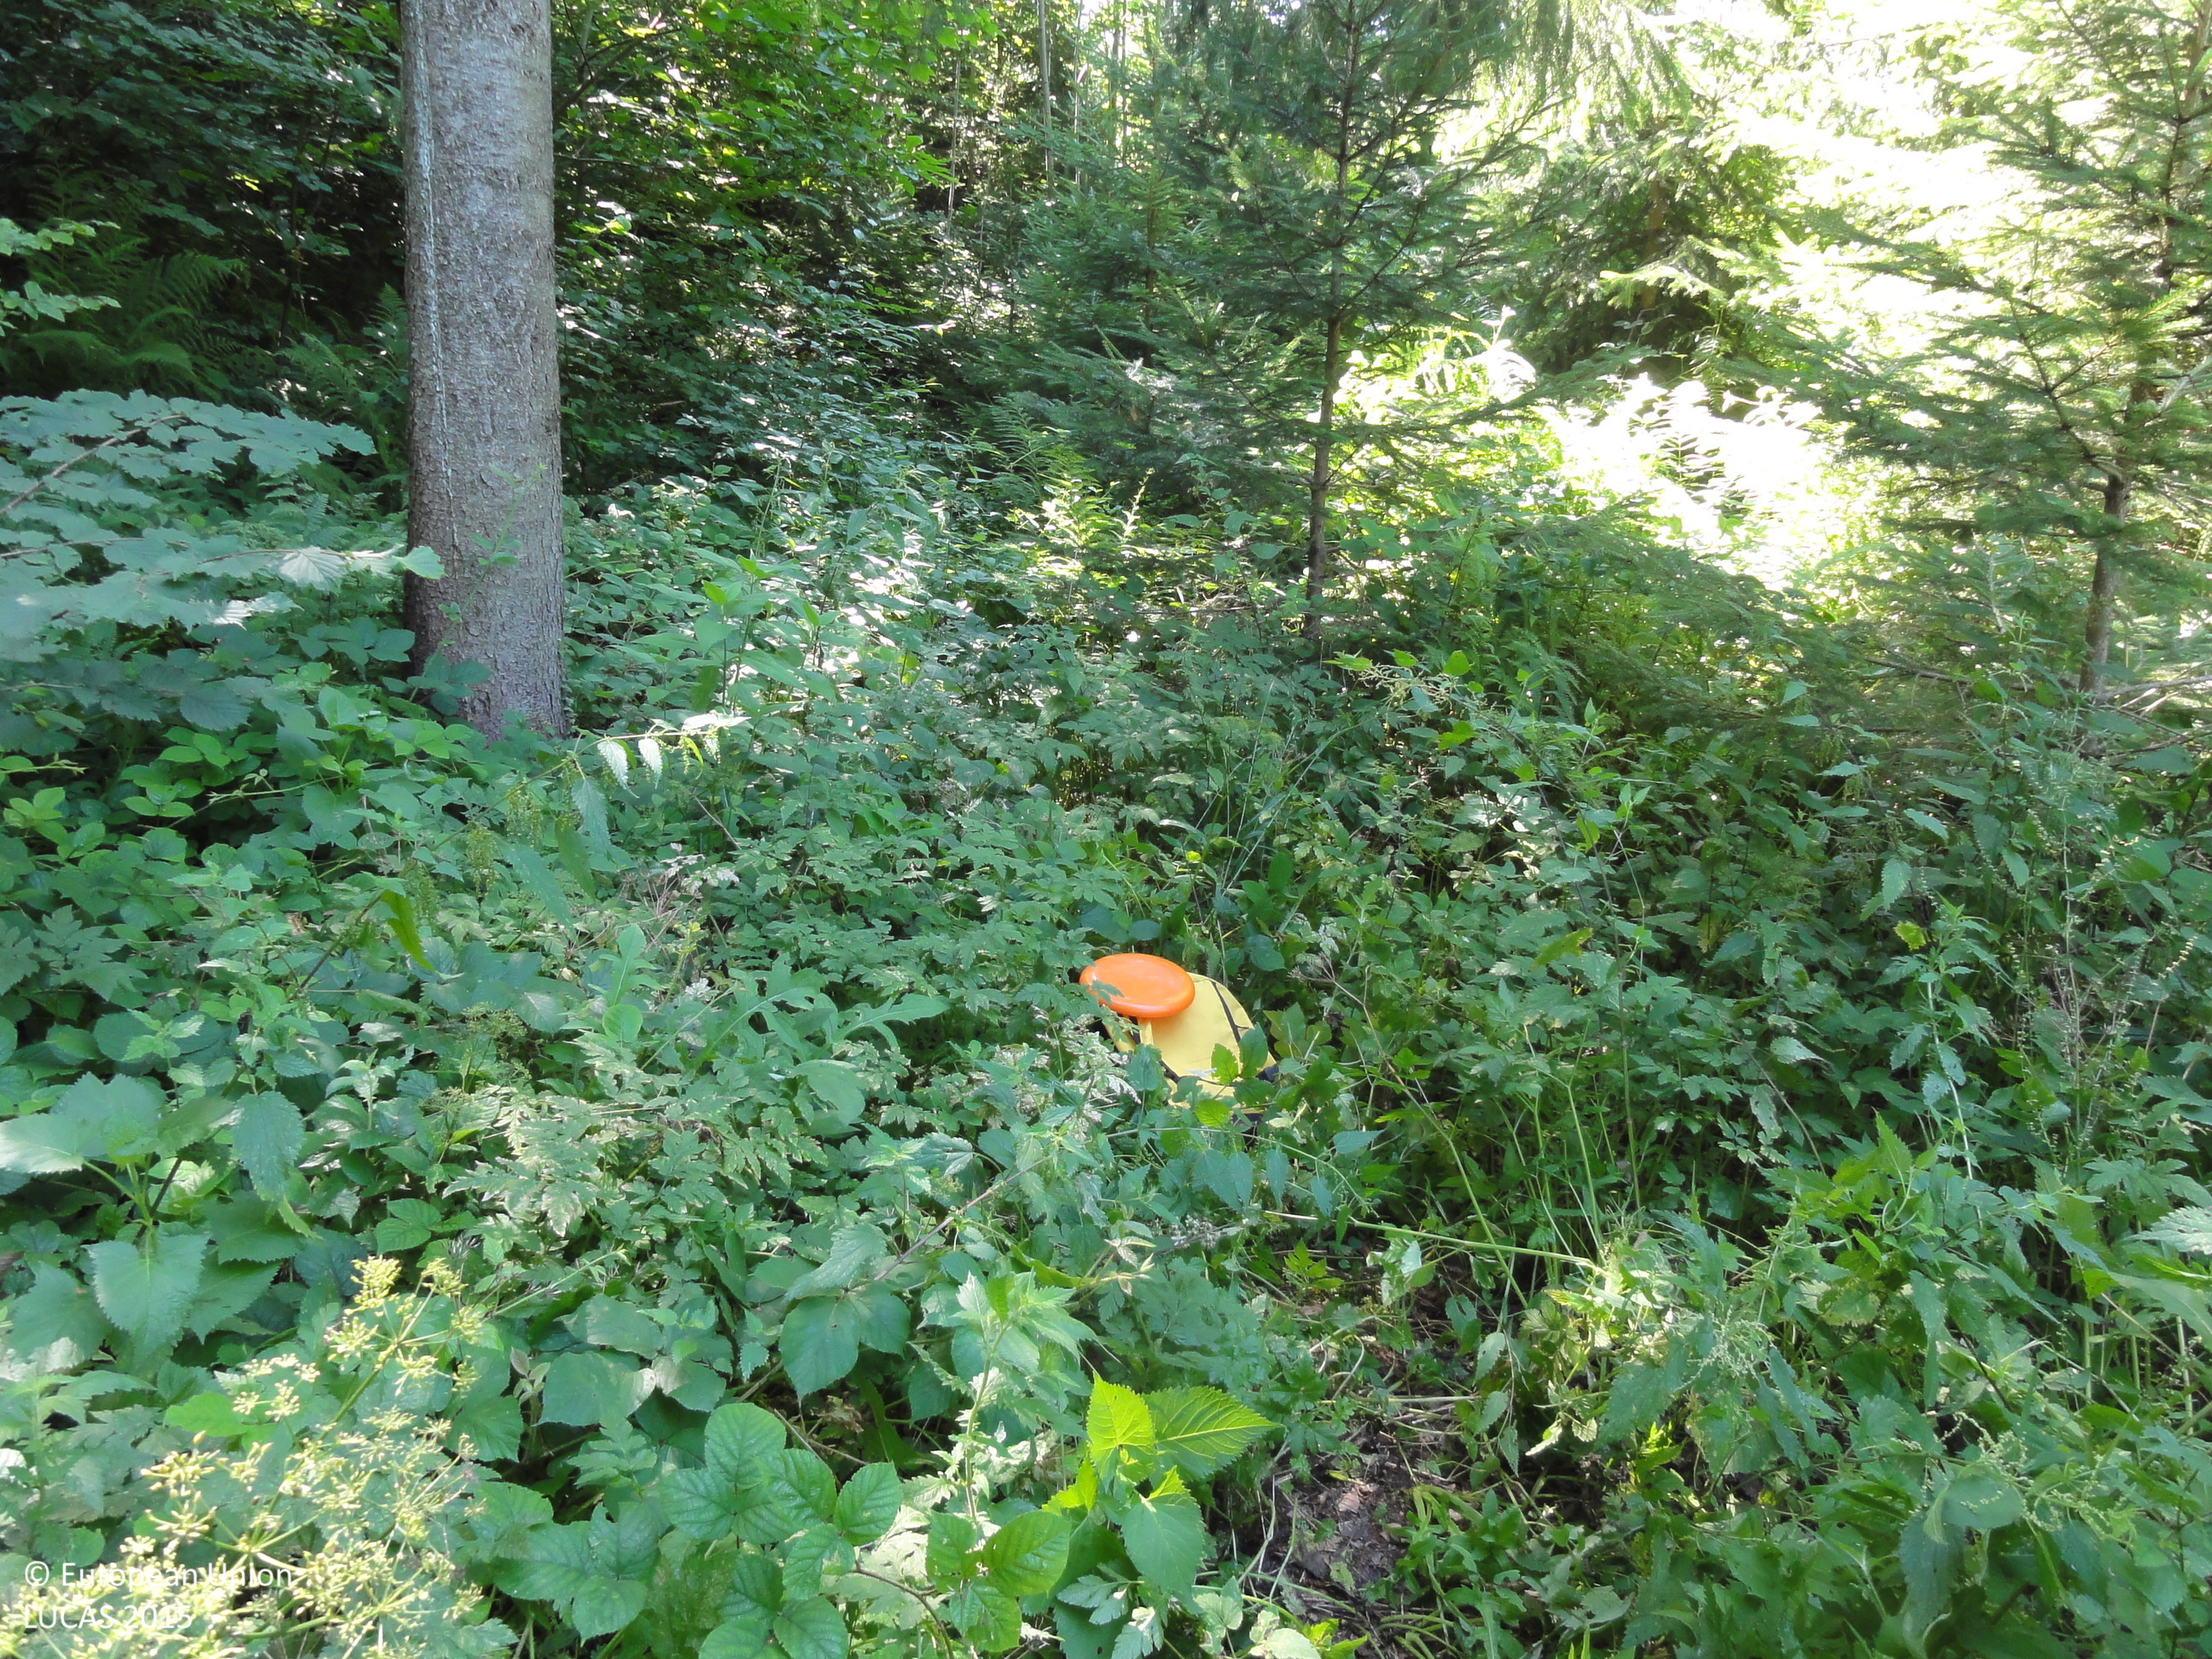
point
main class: Woodland
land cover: Spruce dominated mixed woodland
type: mountainous beech forest
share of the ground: > 75 %
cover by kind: coniferous forest trees 50 %, broadleaved forest trees 50 %
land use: Forestry
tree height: > 5 m
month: July
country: SI
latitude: 46.3389
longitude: 15.0775
